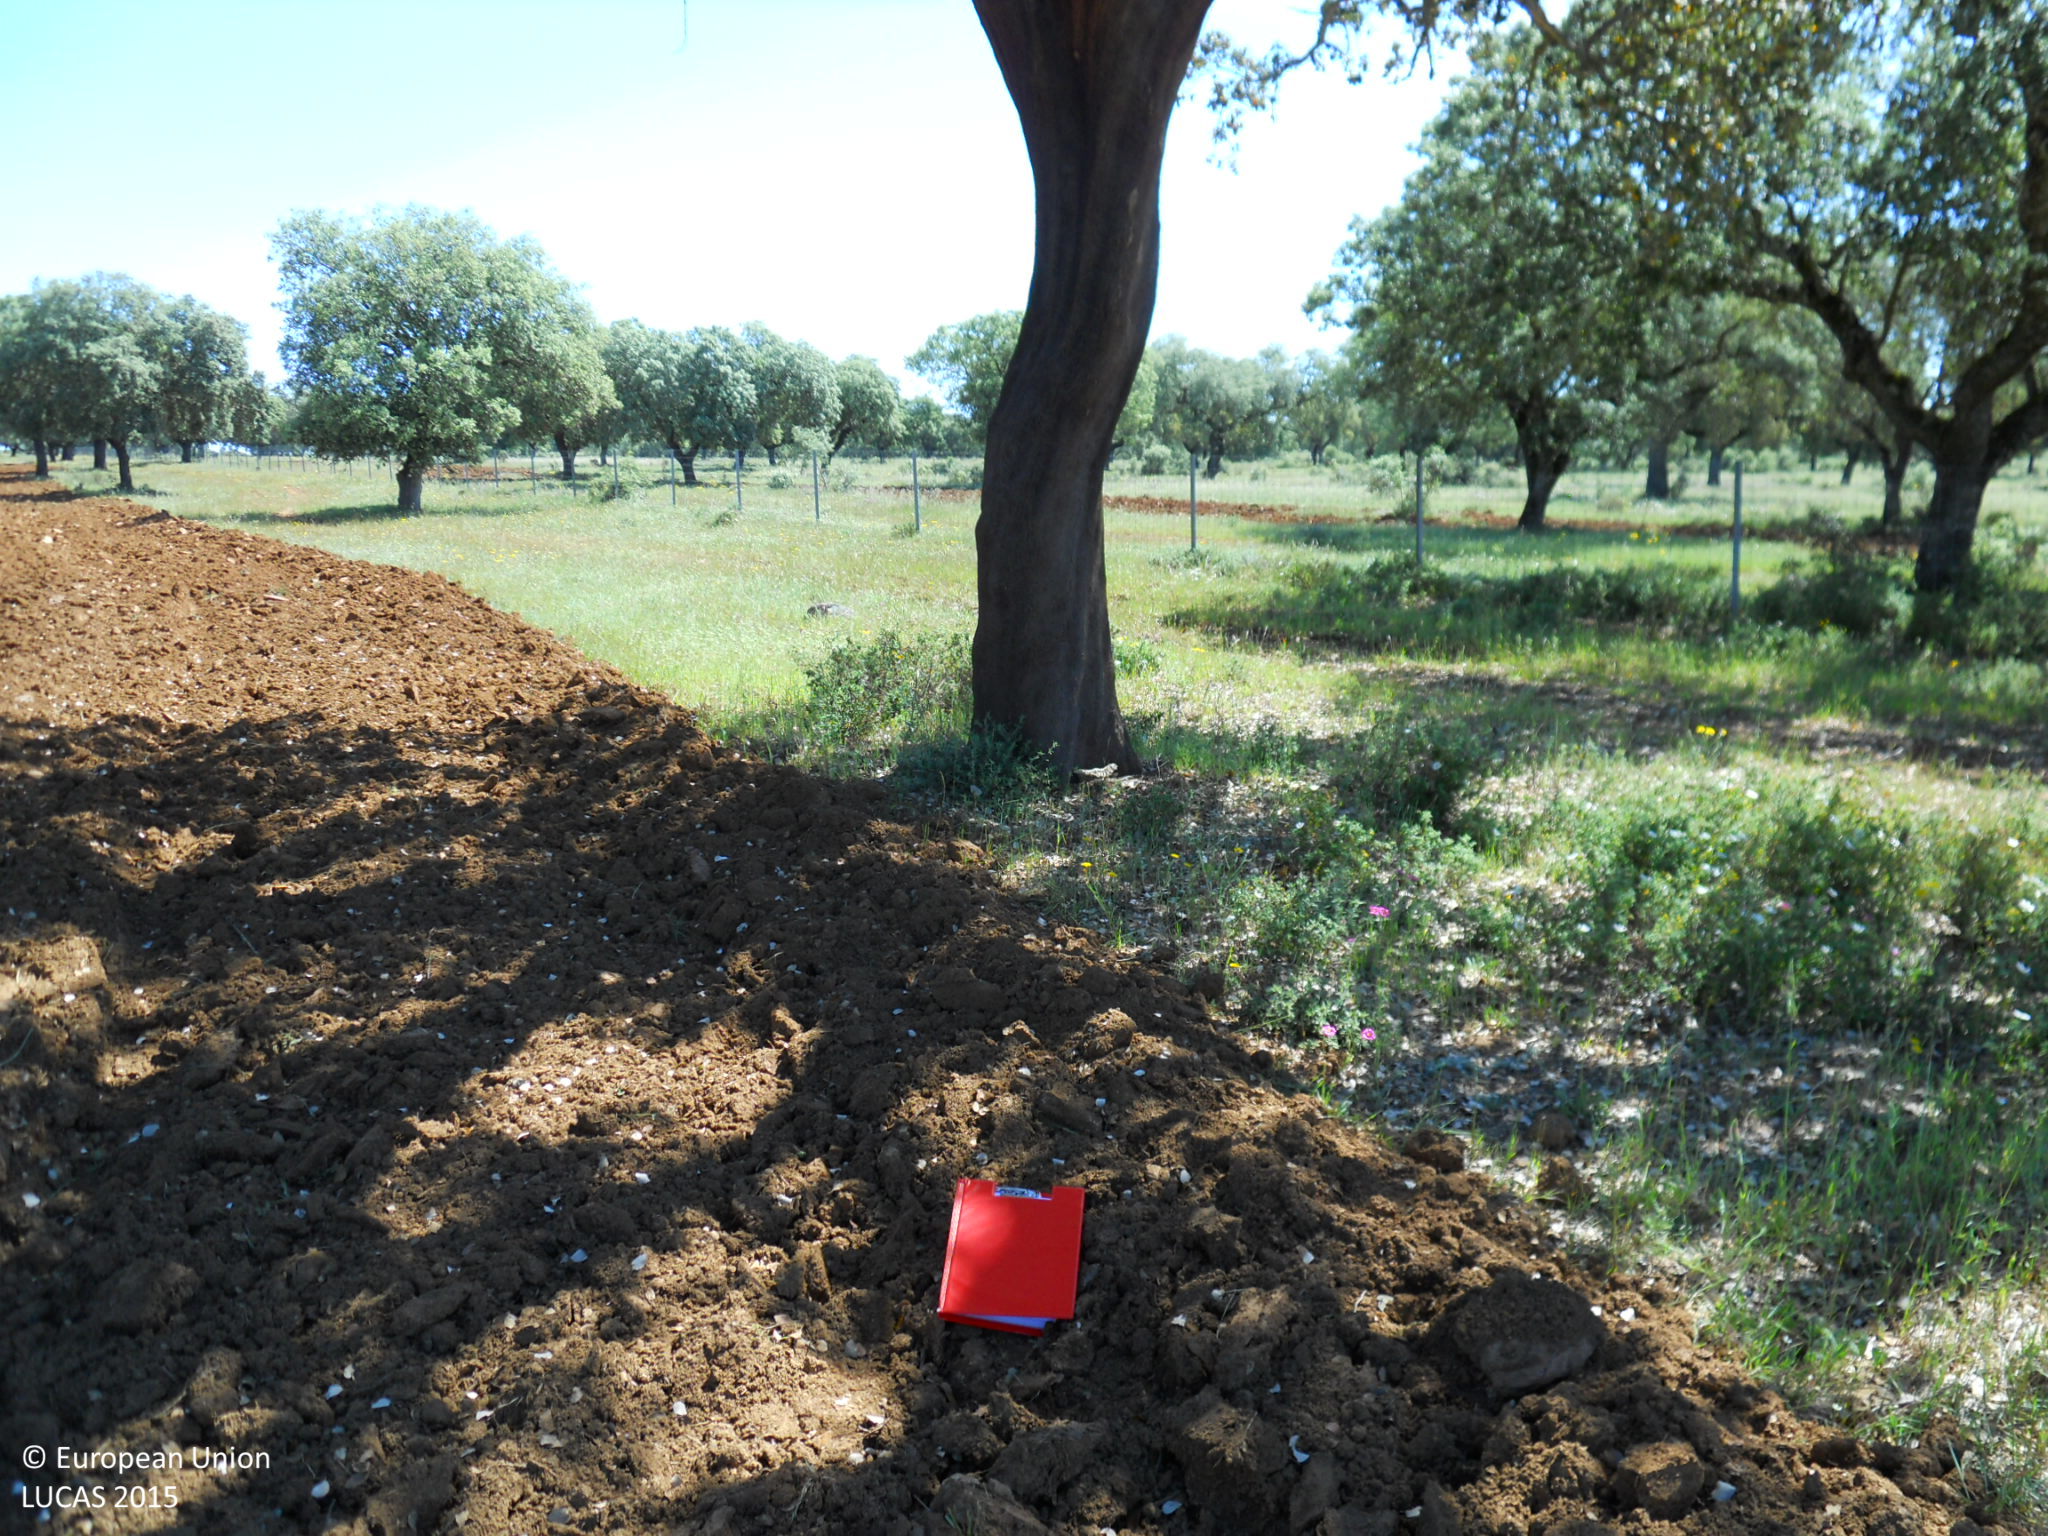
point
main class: Woodland
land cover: Broadleaved woodland
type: broadleaved evergreen forest
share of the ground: > 75 %
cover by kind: broadleaved forest trees 90 %, herbaceous plants 5 %, unconsolidated bare surface 5 %
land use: Forestry
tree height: > 5 m
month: April
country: ES
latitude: 39.1623
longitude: -6.7708
